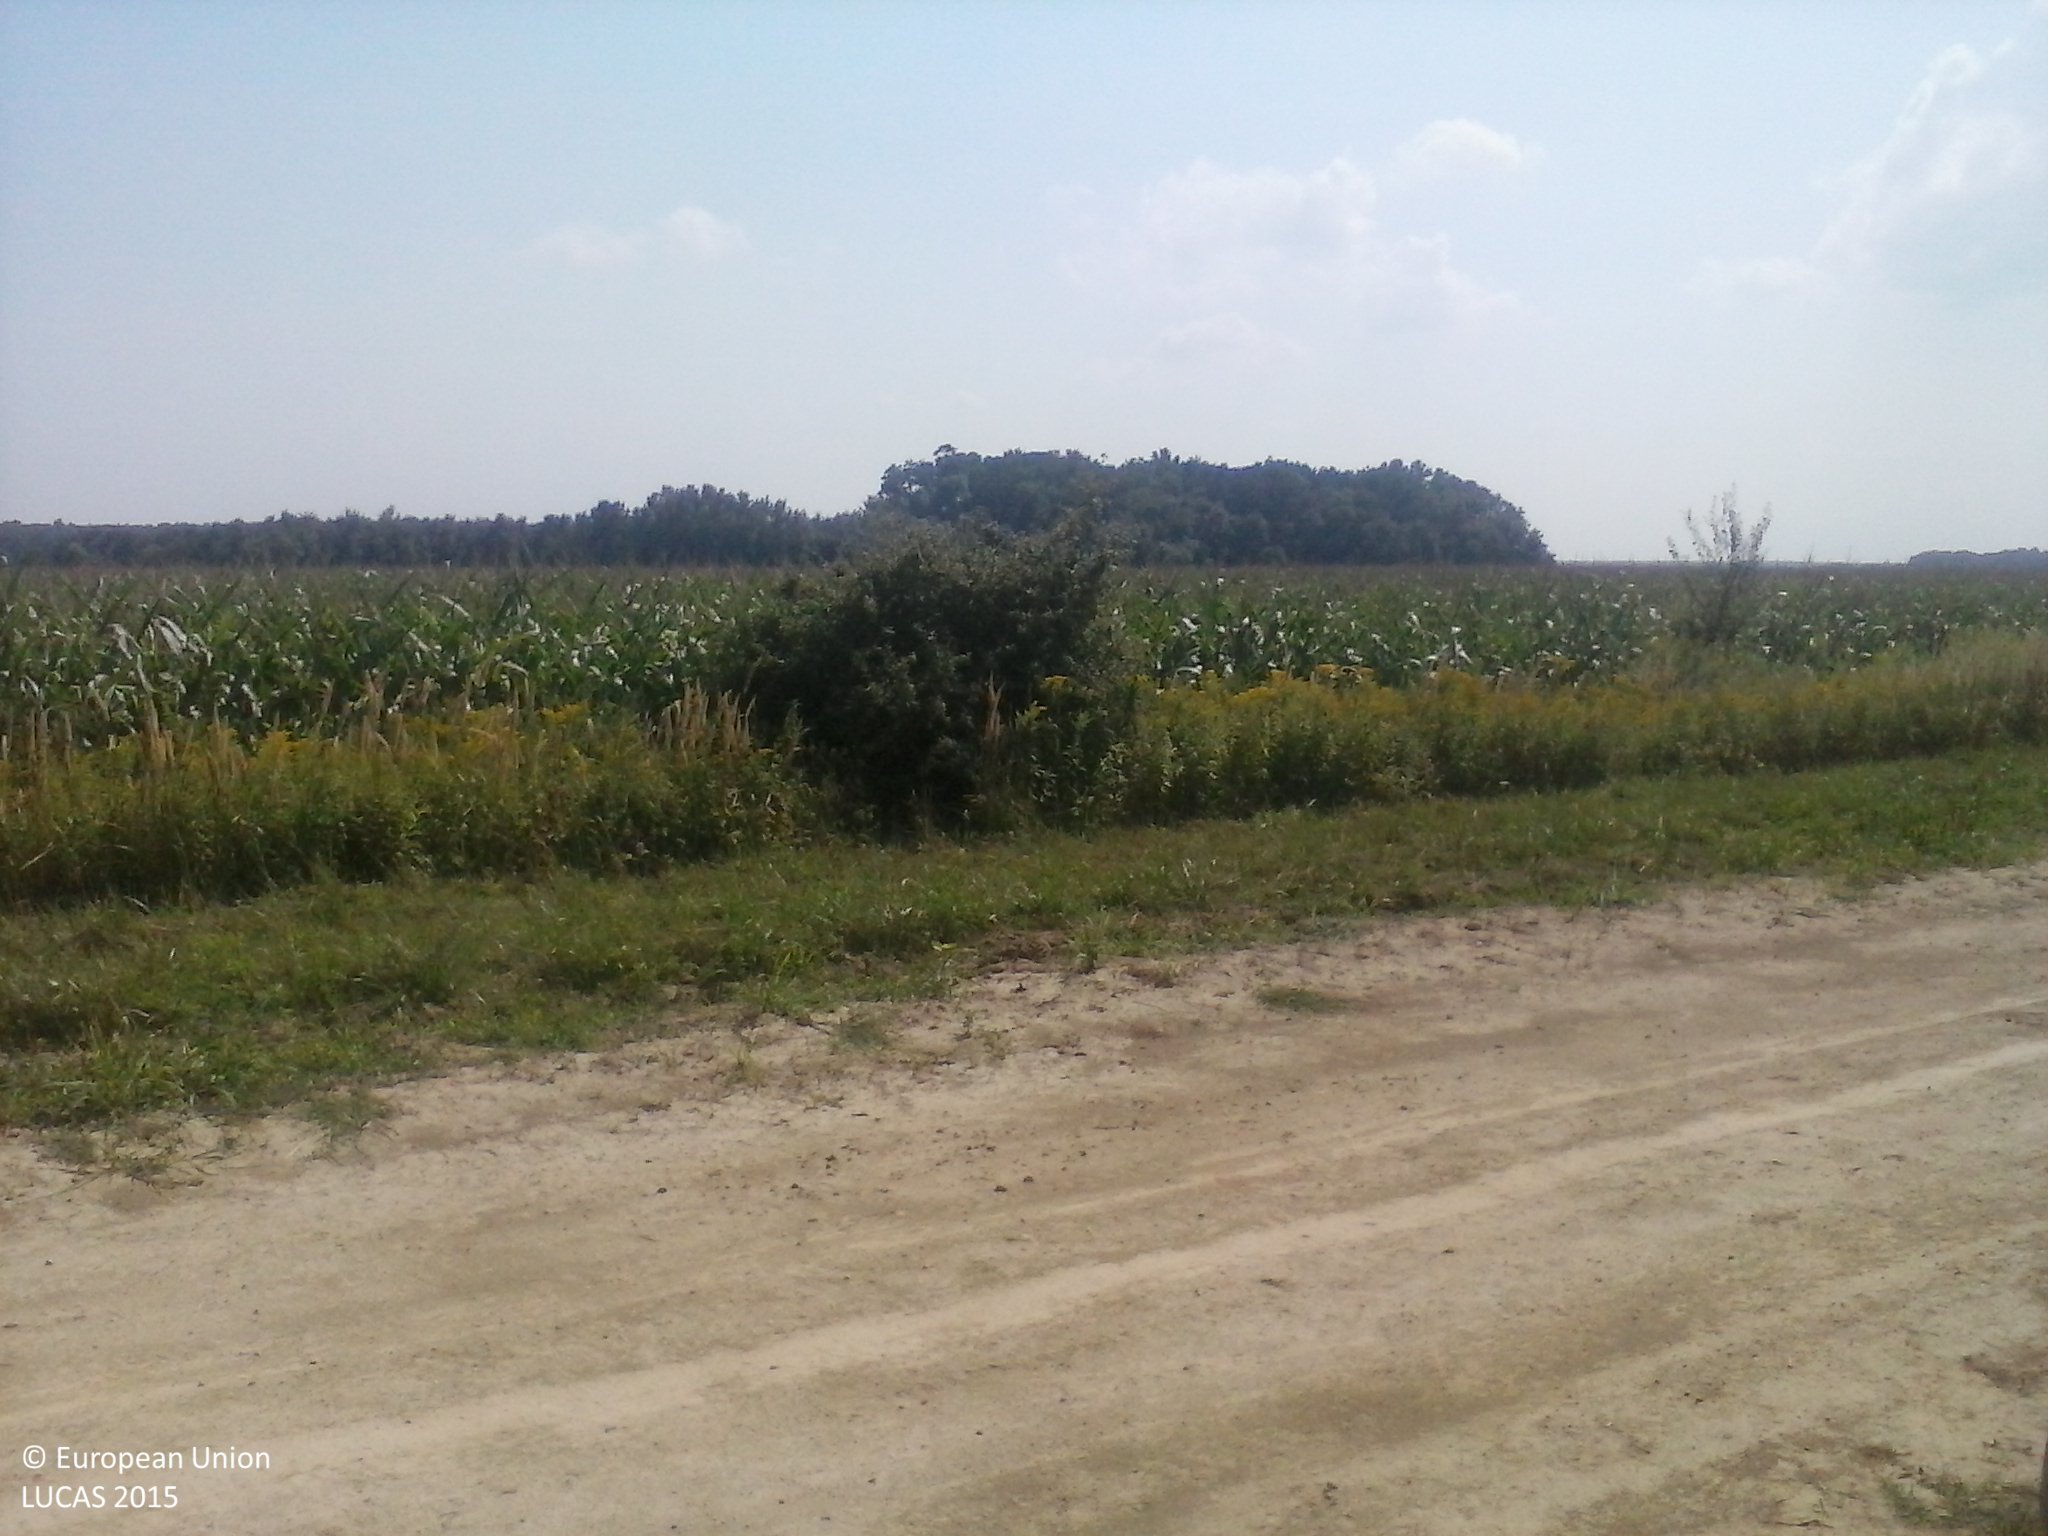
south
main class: Cropland
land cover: Maize
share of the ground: > 75 %
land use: Agriculture (excluding fallow land and kitchen gardens)
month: August
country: HU
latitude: 45.9587
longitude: 17.7848
